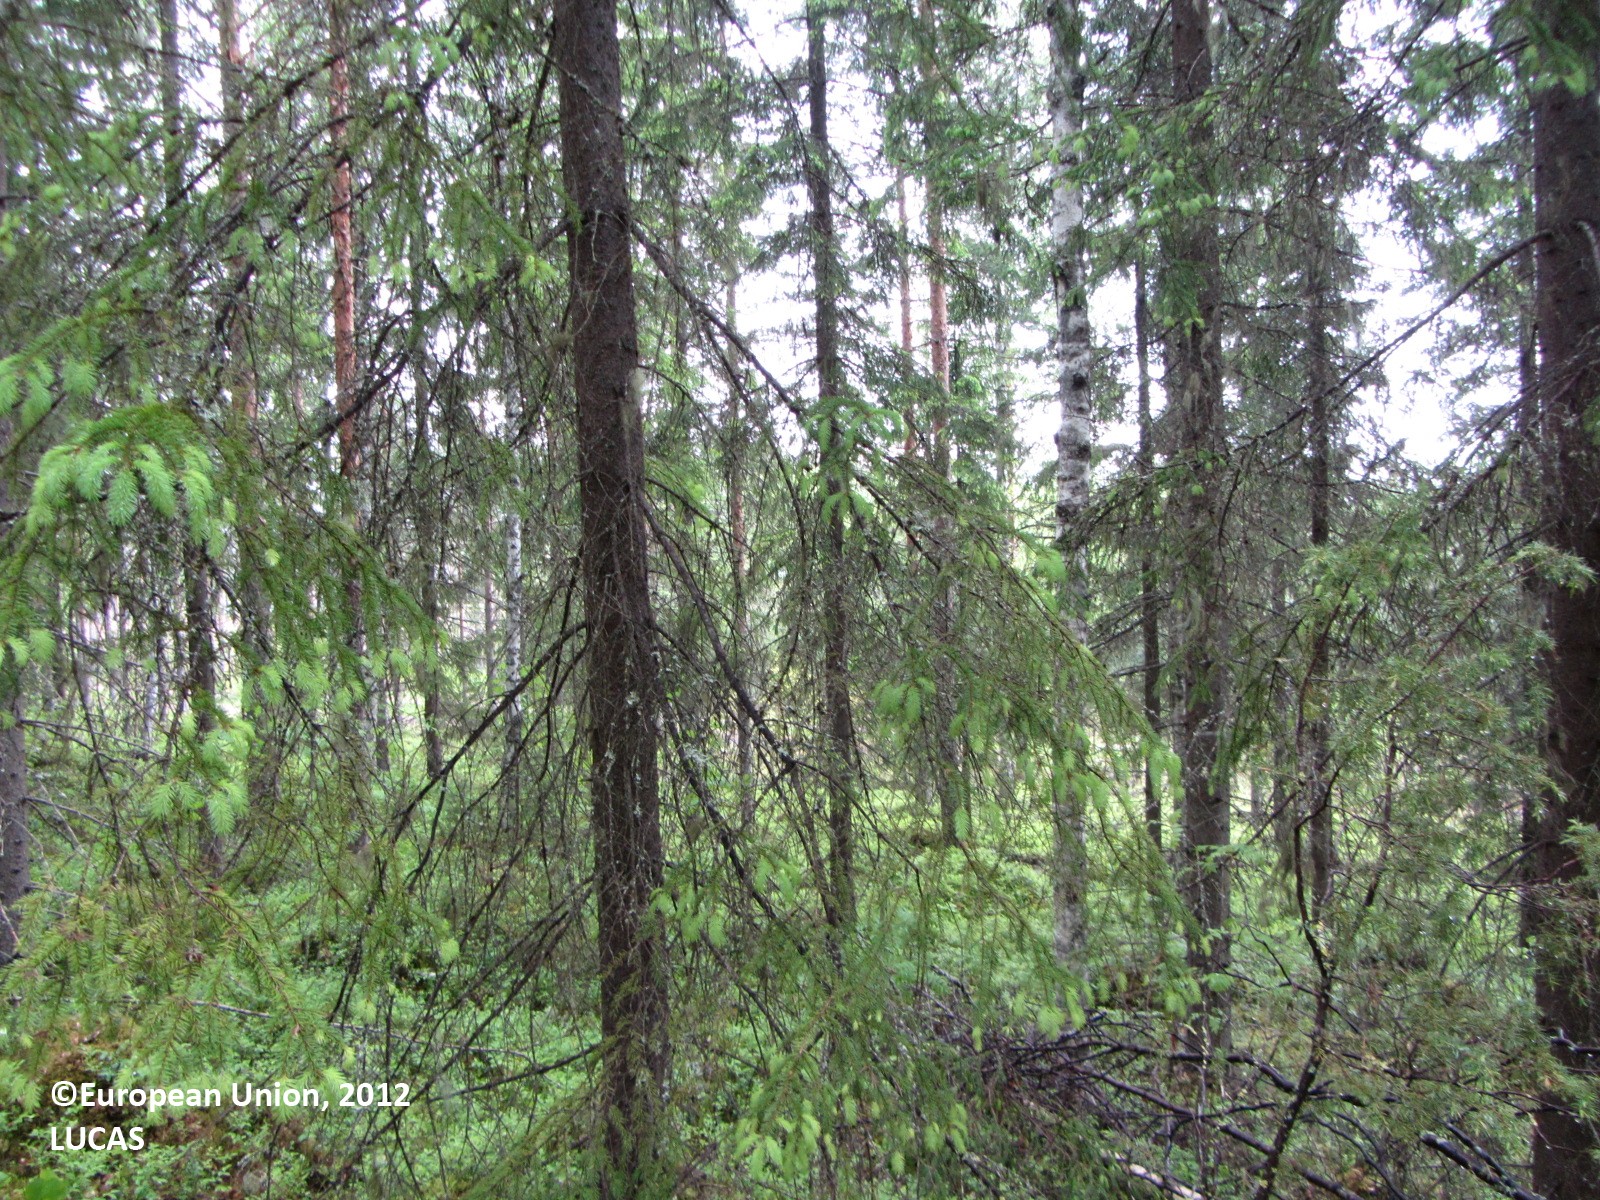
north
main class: Woodland
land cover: Spruce dominated mixed woodland
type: boreal forest
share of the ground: 50 - 75 %
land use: Forestry
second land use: Sport
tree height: > 5 m
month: June
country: FI
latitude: 61.8972
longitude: 25.1231
